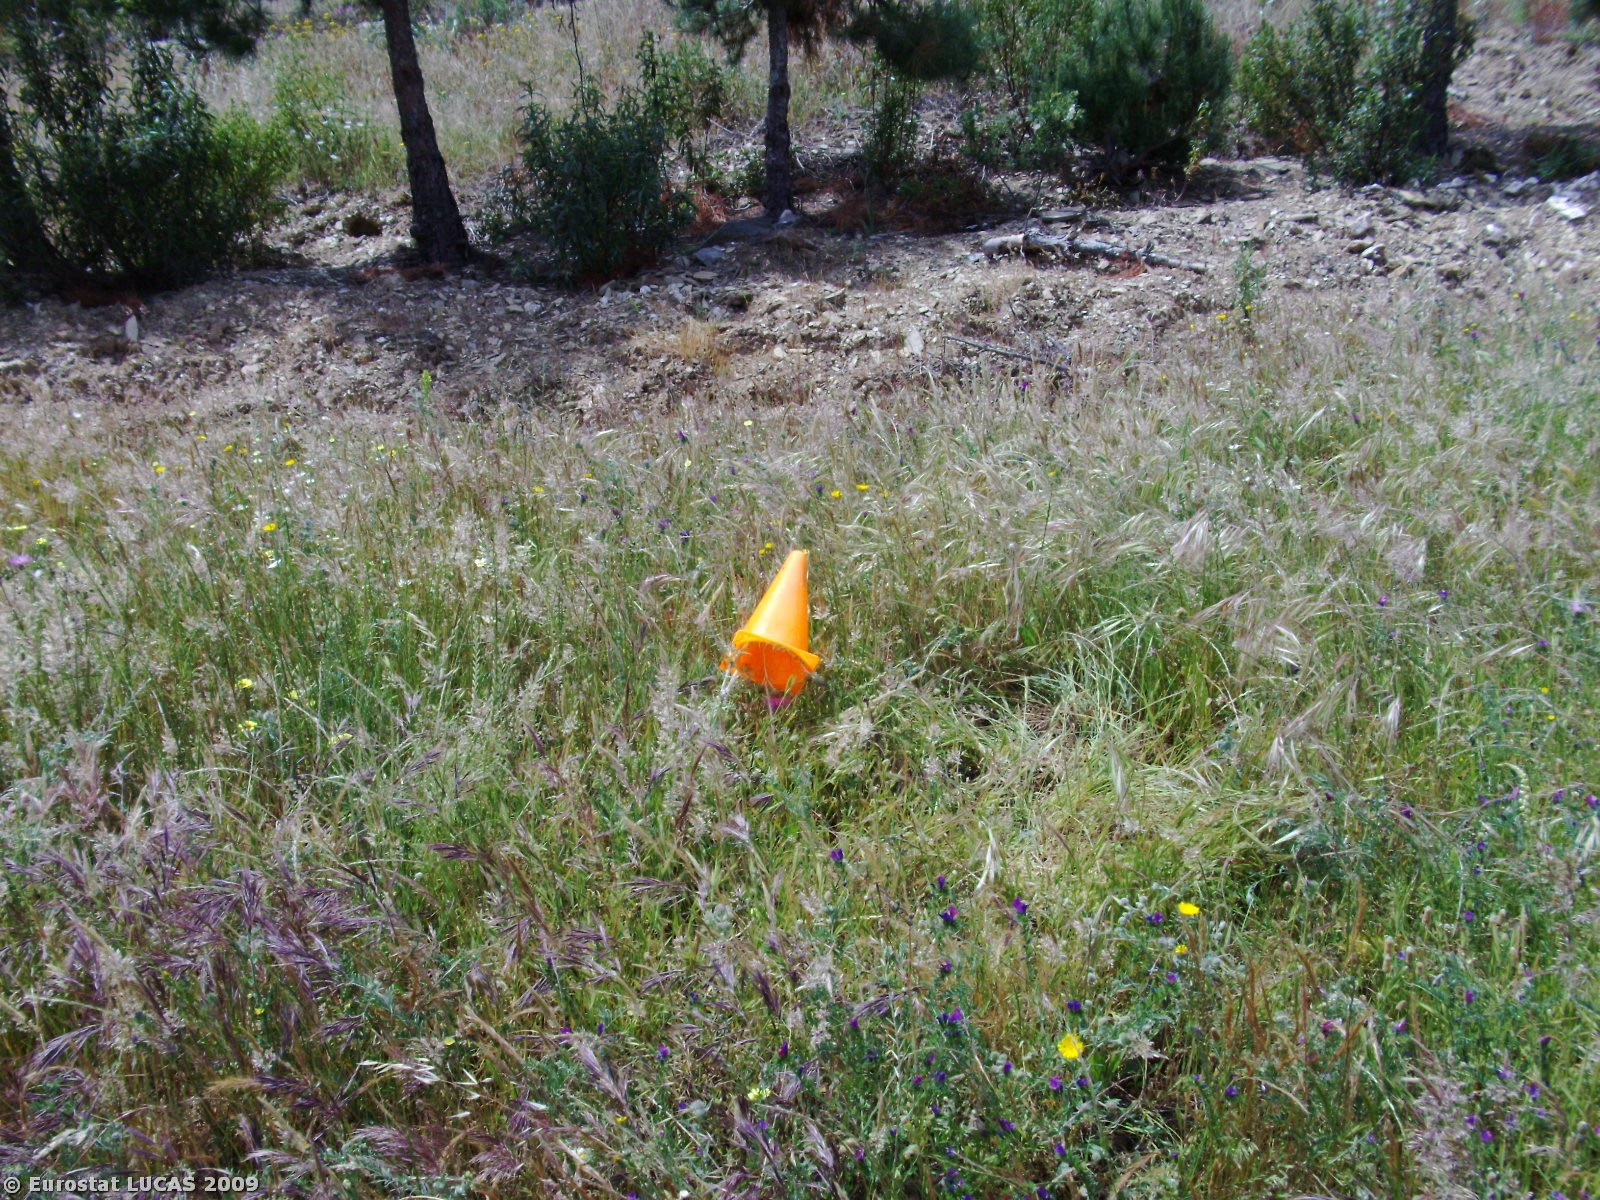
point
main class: Woodland
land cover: Coniferous woodland
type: coniferous forest of the mediterranean region
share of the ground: 10 - 25 %
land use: Forestry
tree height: > 5 m
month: April
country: PT
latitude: 37.5785
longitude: -7.7603
